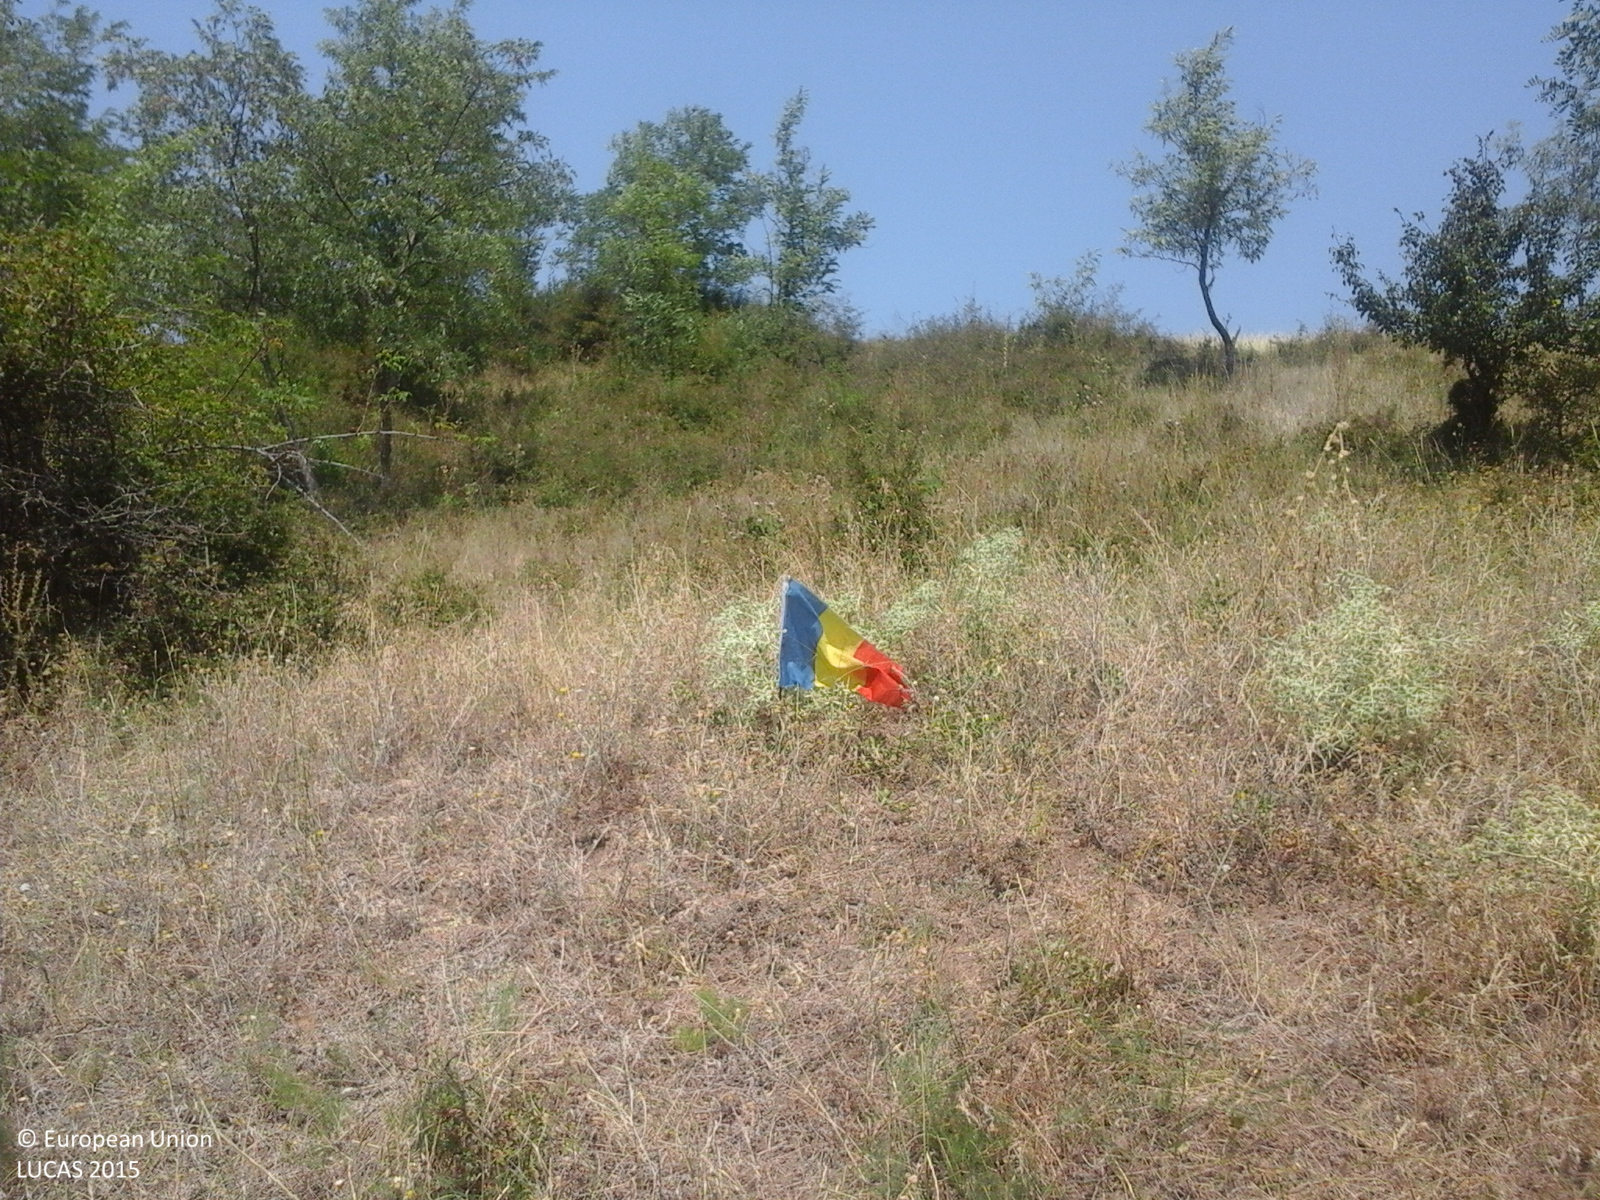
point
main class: Grassland
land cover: Grassland with sparse tree/shrub cover
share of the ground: > 75 %
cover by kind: herbaceous plants 85 %, shrubs 10 %, broadleaved forest trees 5 %
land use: Agriculture (excluding fallow land and kitchen gardens)
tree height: < 5 m
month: August
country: RO
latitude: 44.6124
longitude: 23.0900
